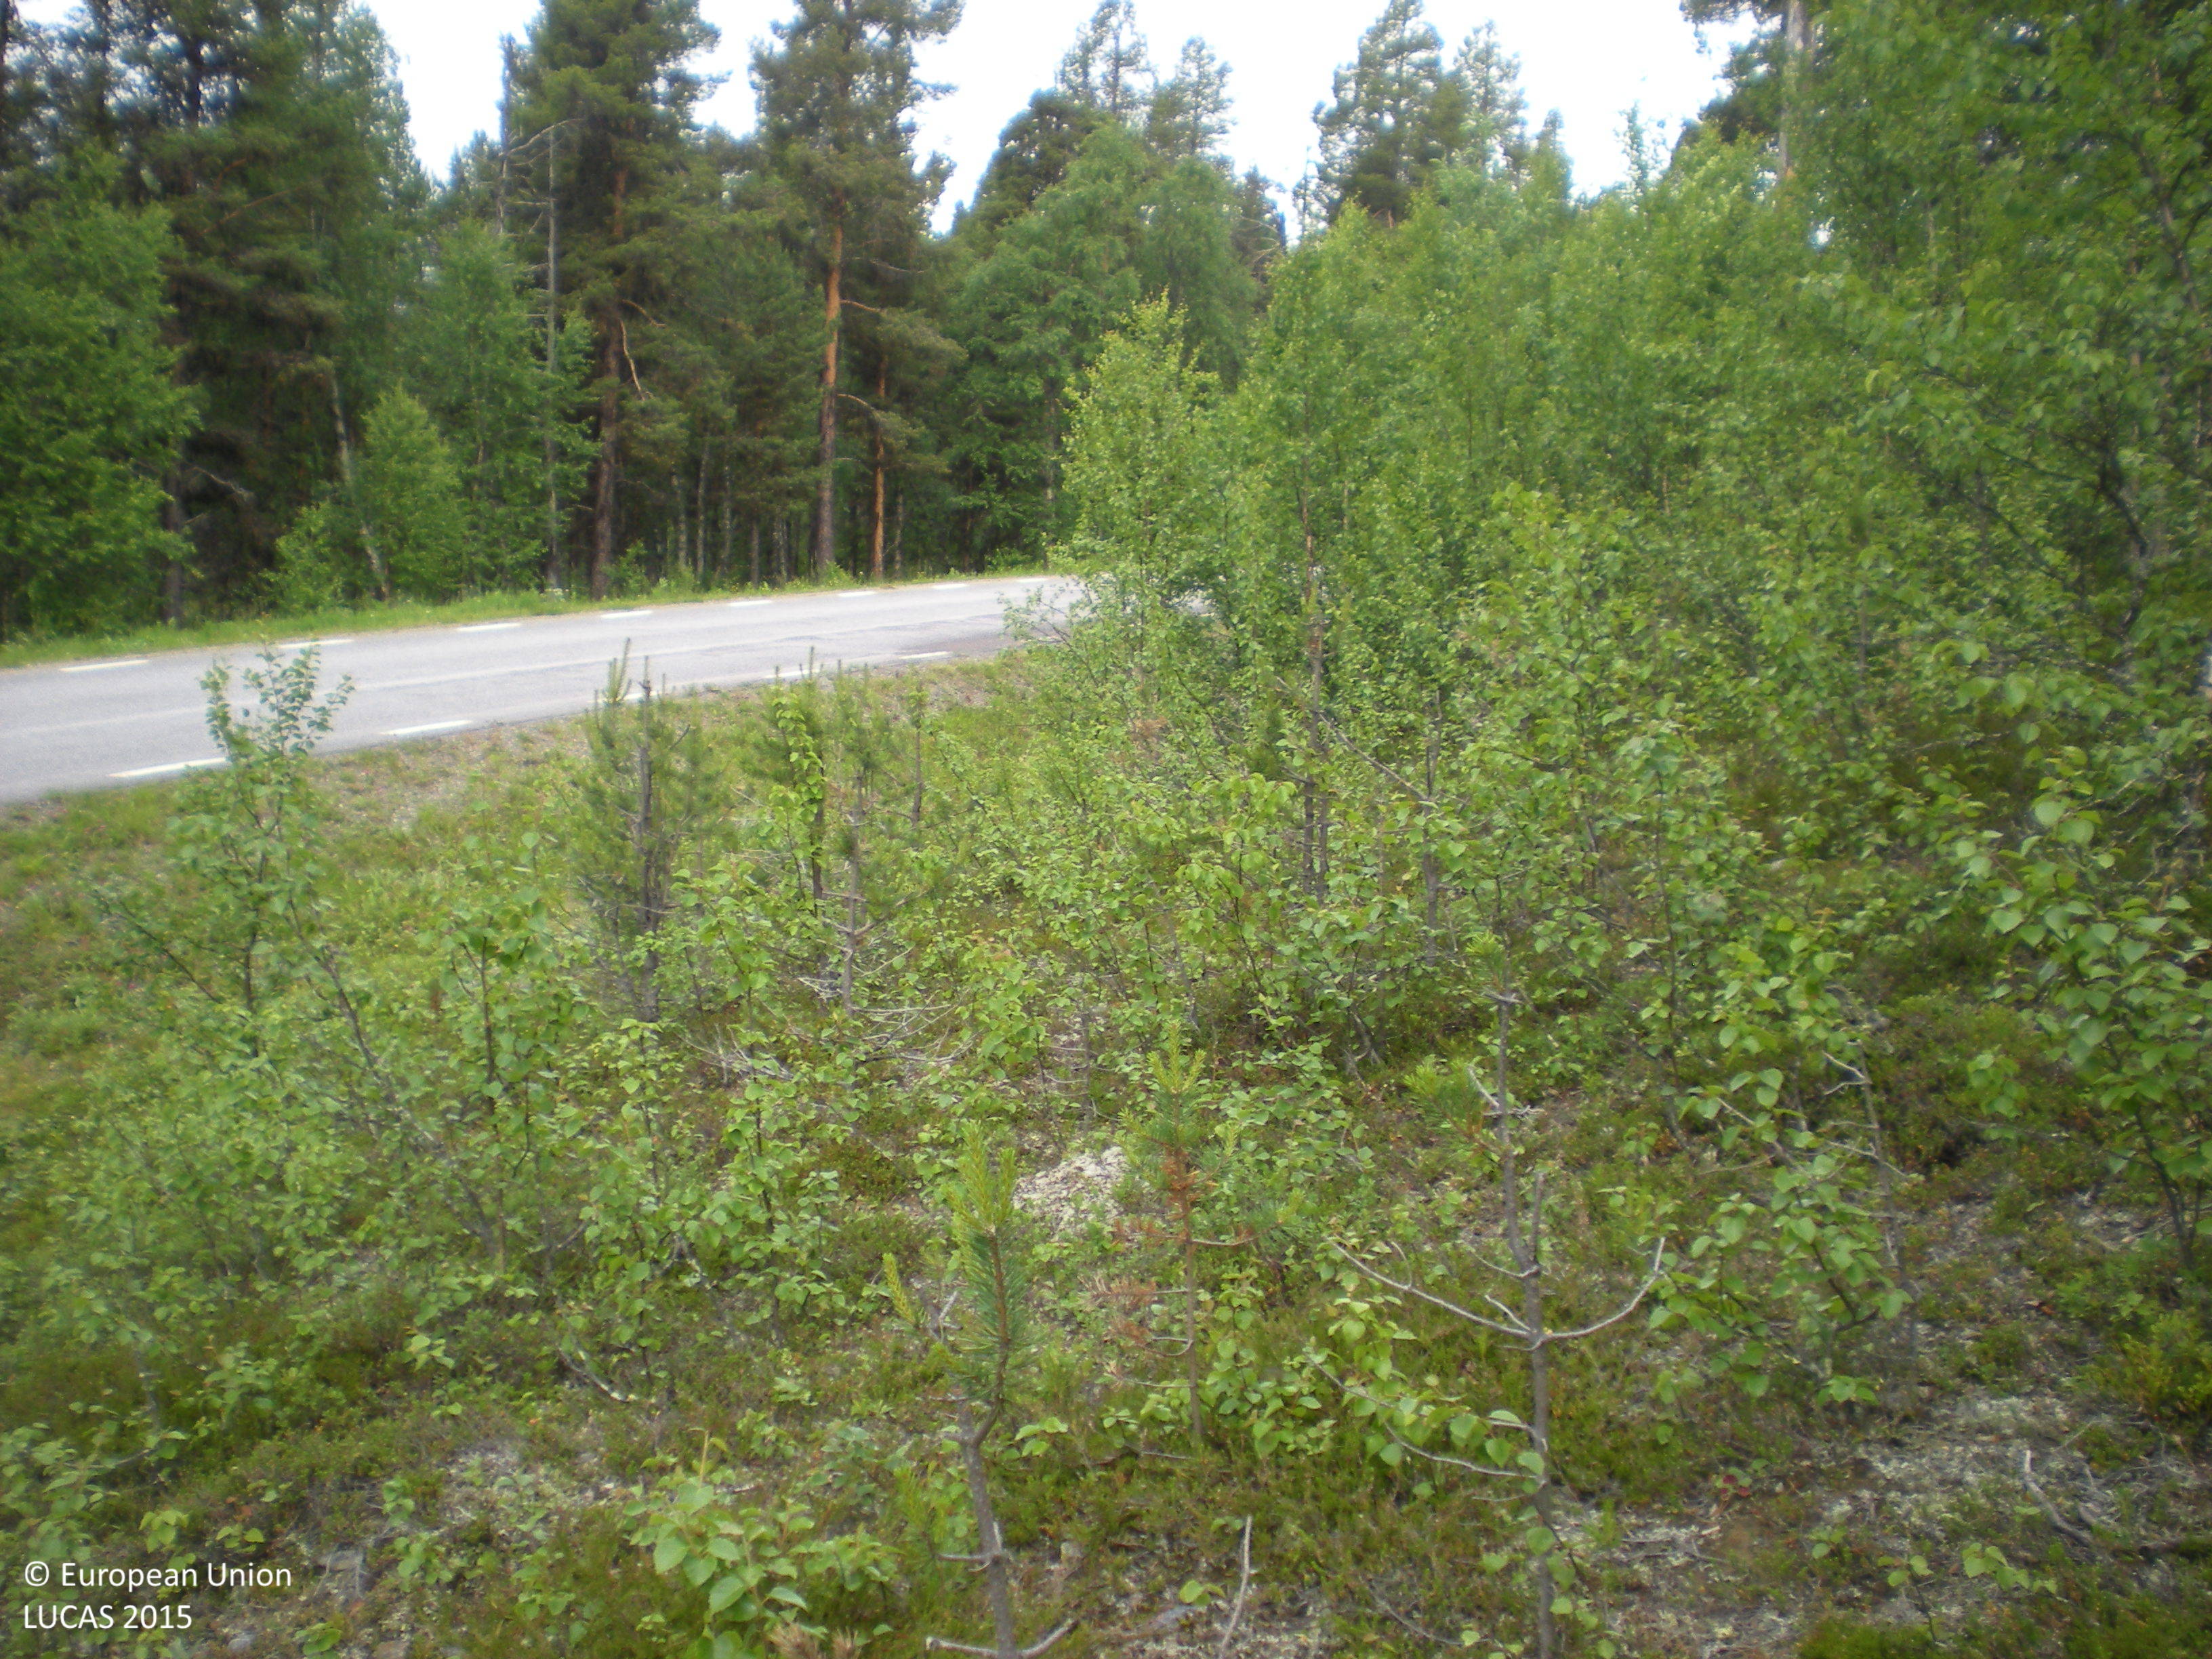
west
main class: Woodland
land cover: Broadleaved woodland
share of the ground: 25 - 50 %
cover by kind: broadleaved forest trees 40 %, shrubs 40 %, lichens and mosses 10 %, coniferous forest trees 5 %, consolidated bare surface 5 %
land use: Forestry
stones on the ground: > 50 %
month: July
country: SE
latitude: 66.2422
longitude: 16.9620
